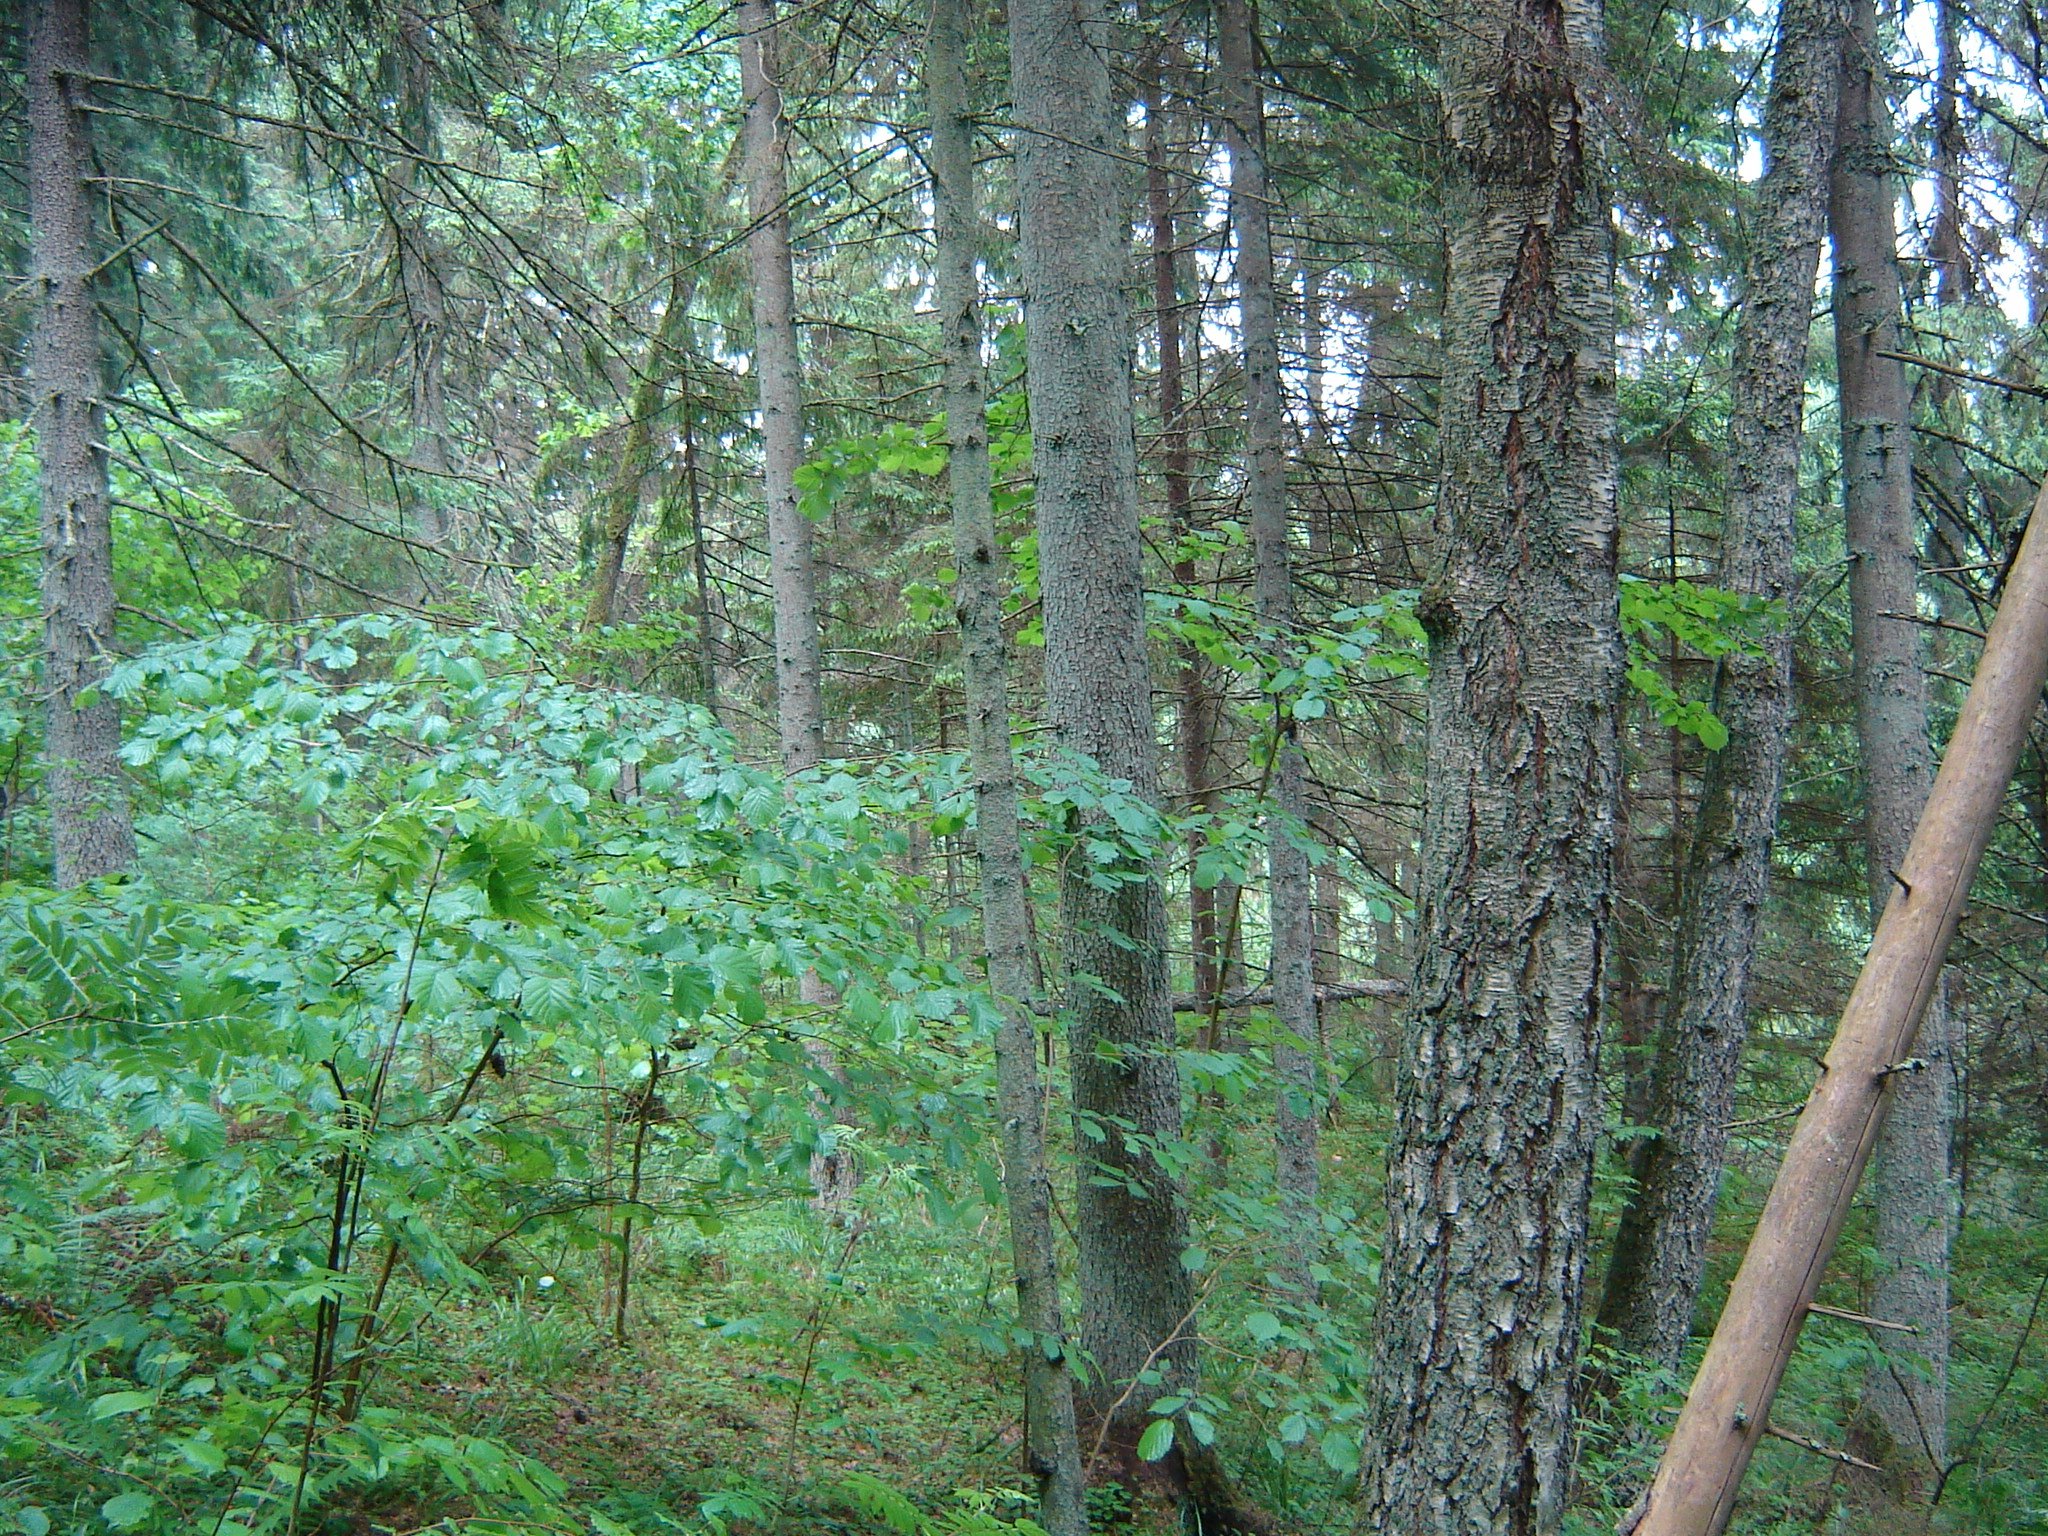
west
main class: Woodland
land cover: Spruce dominated coniferous woodland
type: hemiboreal forest and nemoral coniferous forest and mixed broadleaved-coniferous forest
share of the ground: > 75 %
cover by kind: coniferous forest trees 90 %, broadleaved forest trees 10 %
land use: Forestry
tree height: > 5 m
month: June
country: LT
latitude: 55.6594
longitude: 25.2006
